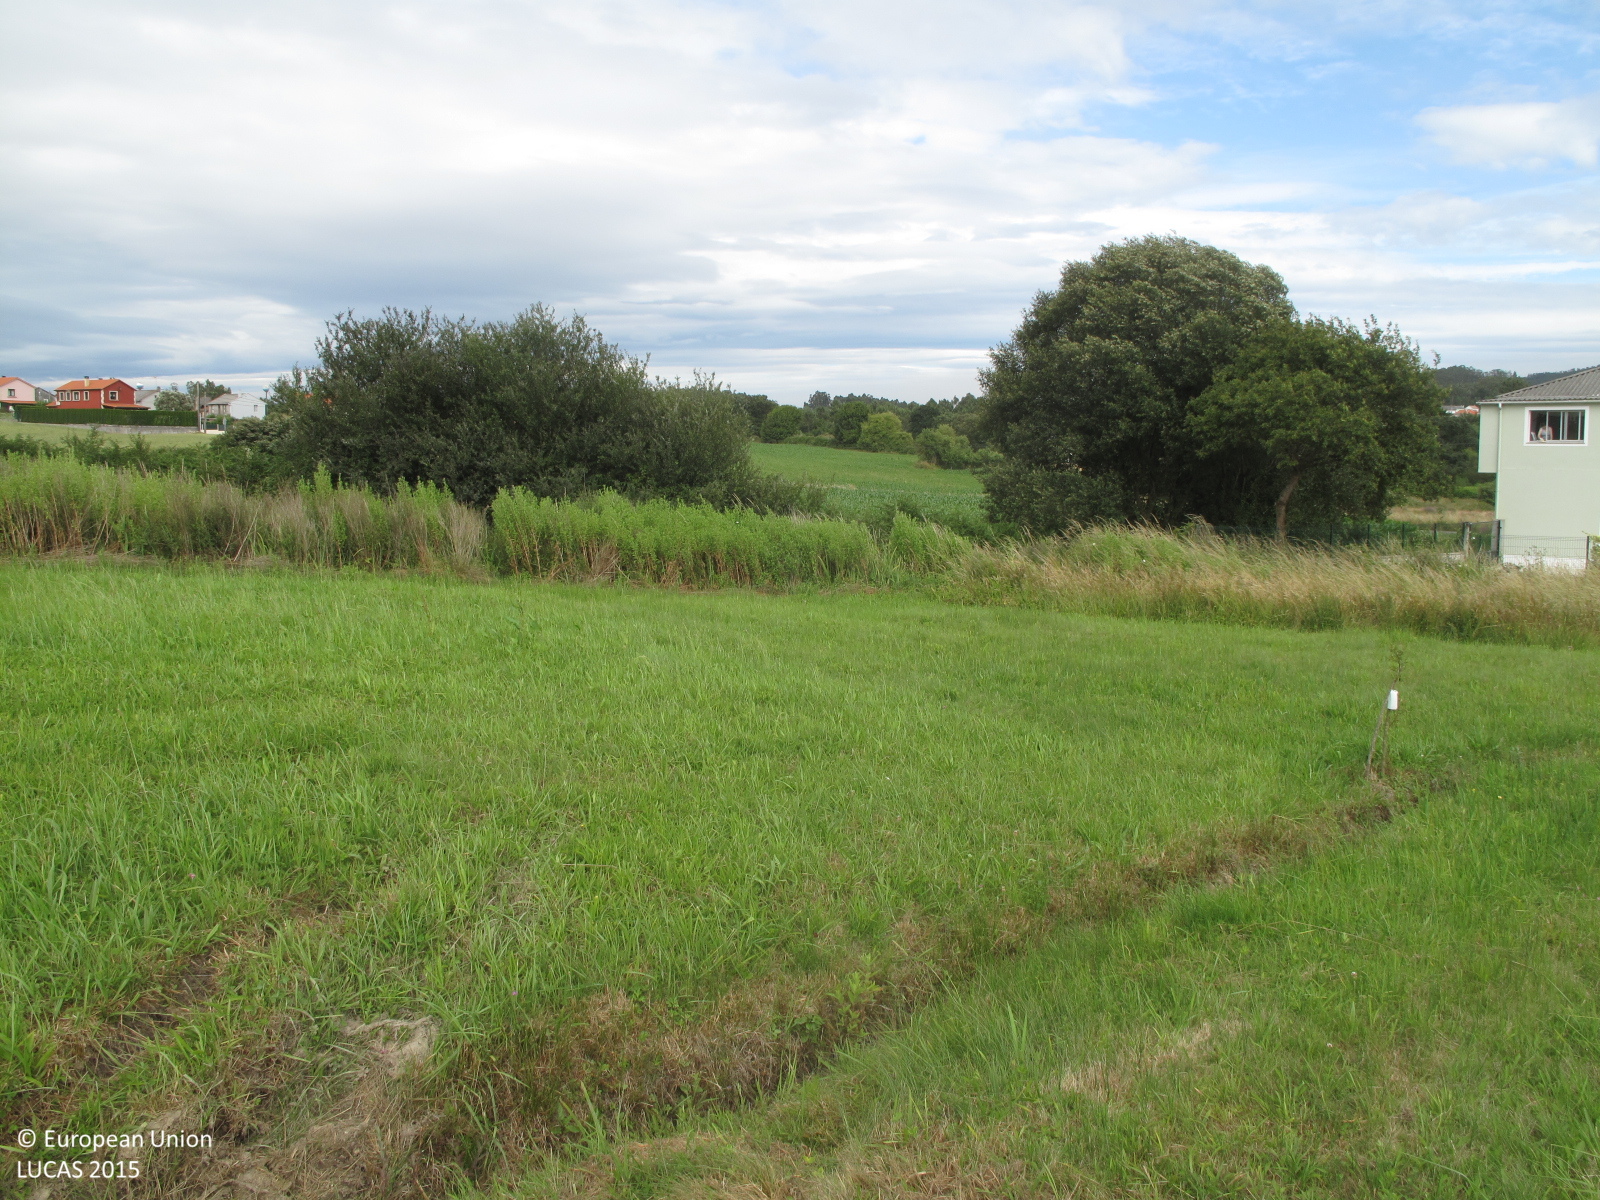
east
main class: Grassland
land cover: Grassland without tree/shrub cover
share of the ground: > 75 %
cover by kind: herbaceous plants 100 %
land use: Agriculture (excluding fallow land and kitchen gardens)
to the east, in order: Grassland without tree/shrub cover; Shruby margins; Tracks; Groves; Shruby margins; Maize; Shruby margins; Paved roads, cycling and walking lanes; Shruby margins; Electric lines; Maize
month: July
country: ES
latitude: 43.2423
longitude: -8.5964
